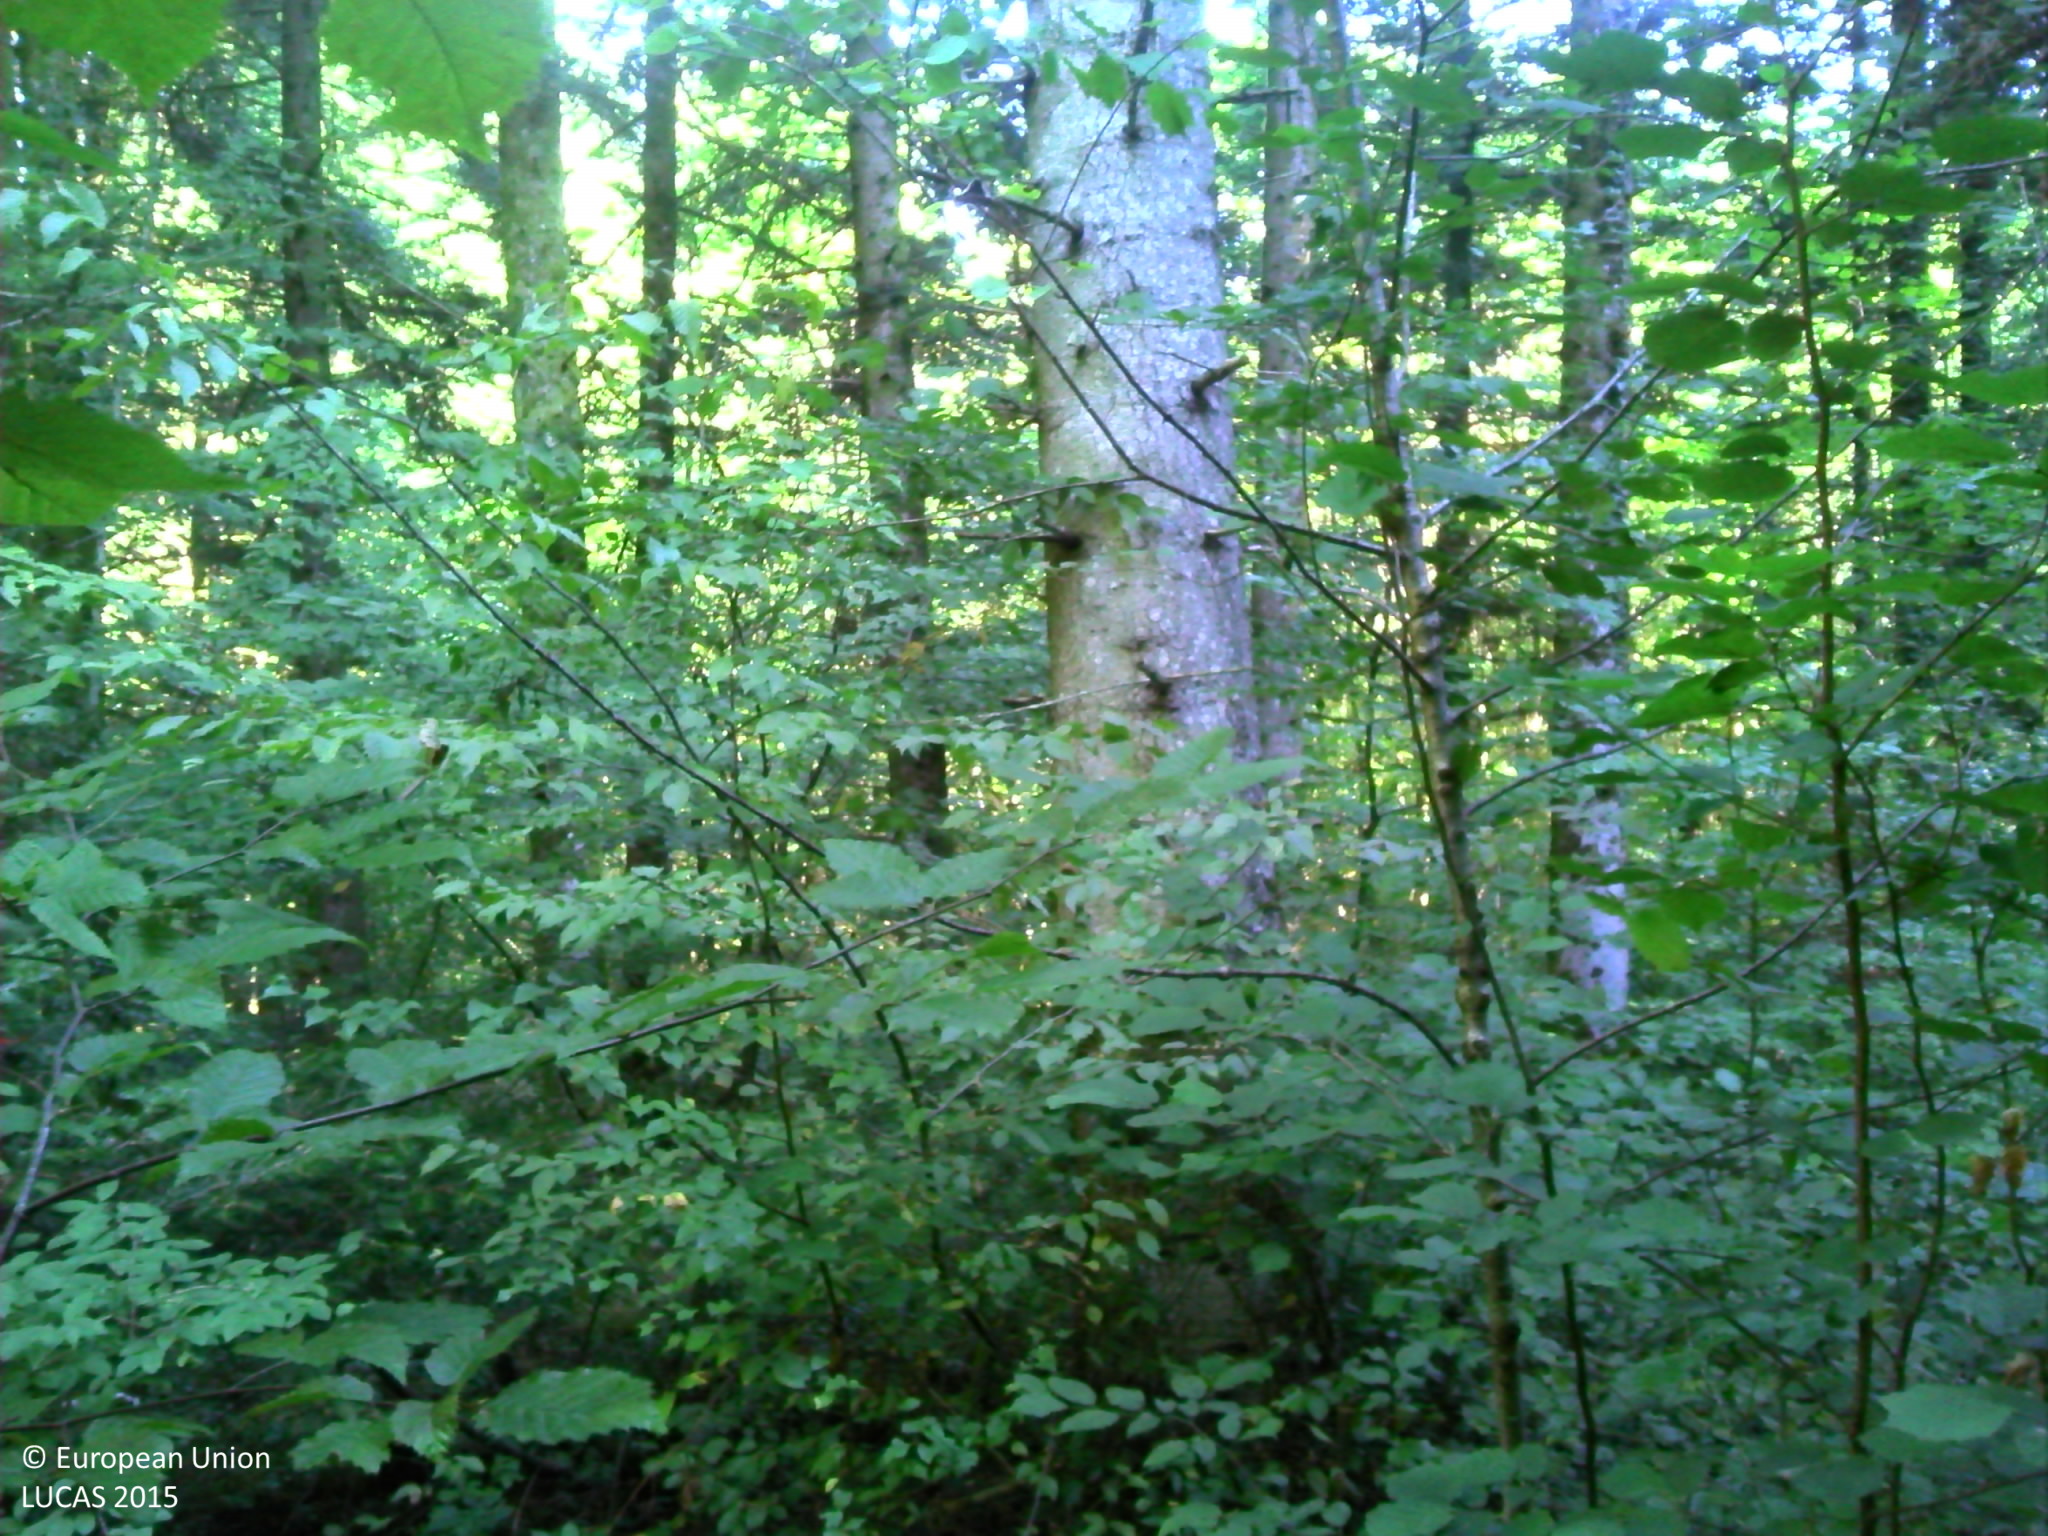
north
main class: Woodland
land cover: Spruce dominated mixed woodland
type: mesophytic deciduous forest
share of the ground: > 75 %
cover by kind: coniferous forest trees 40 %, broadleaved forest trees 40 %, shrubs 5 %, herbaceous plants 5 %, lichens and mosses 5 %, consolidated bare surface 5 %
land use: Forestry
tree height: > 5 m
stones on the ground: < 10 %
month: September
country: FR
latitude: 47.2782
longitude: 6.2871
